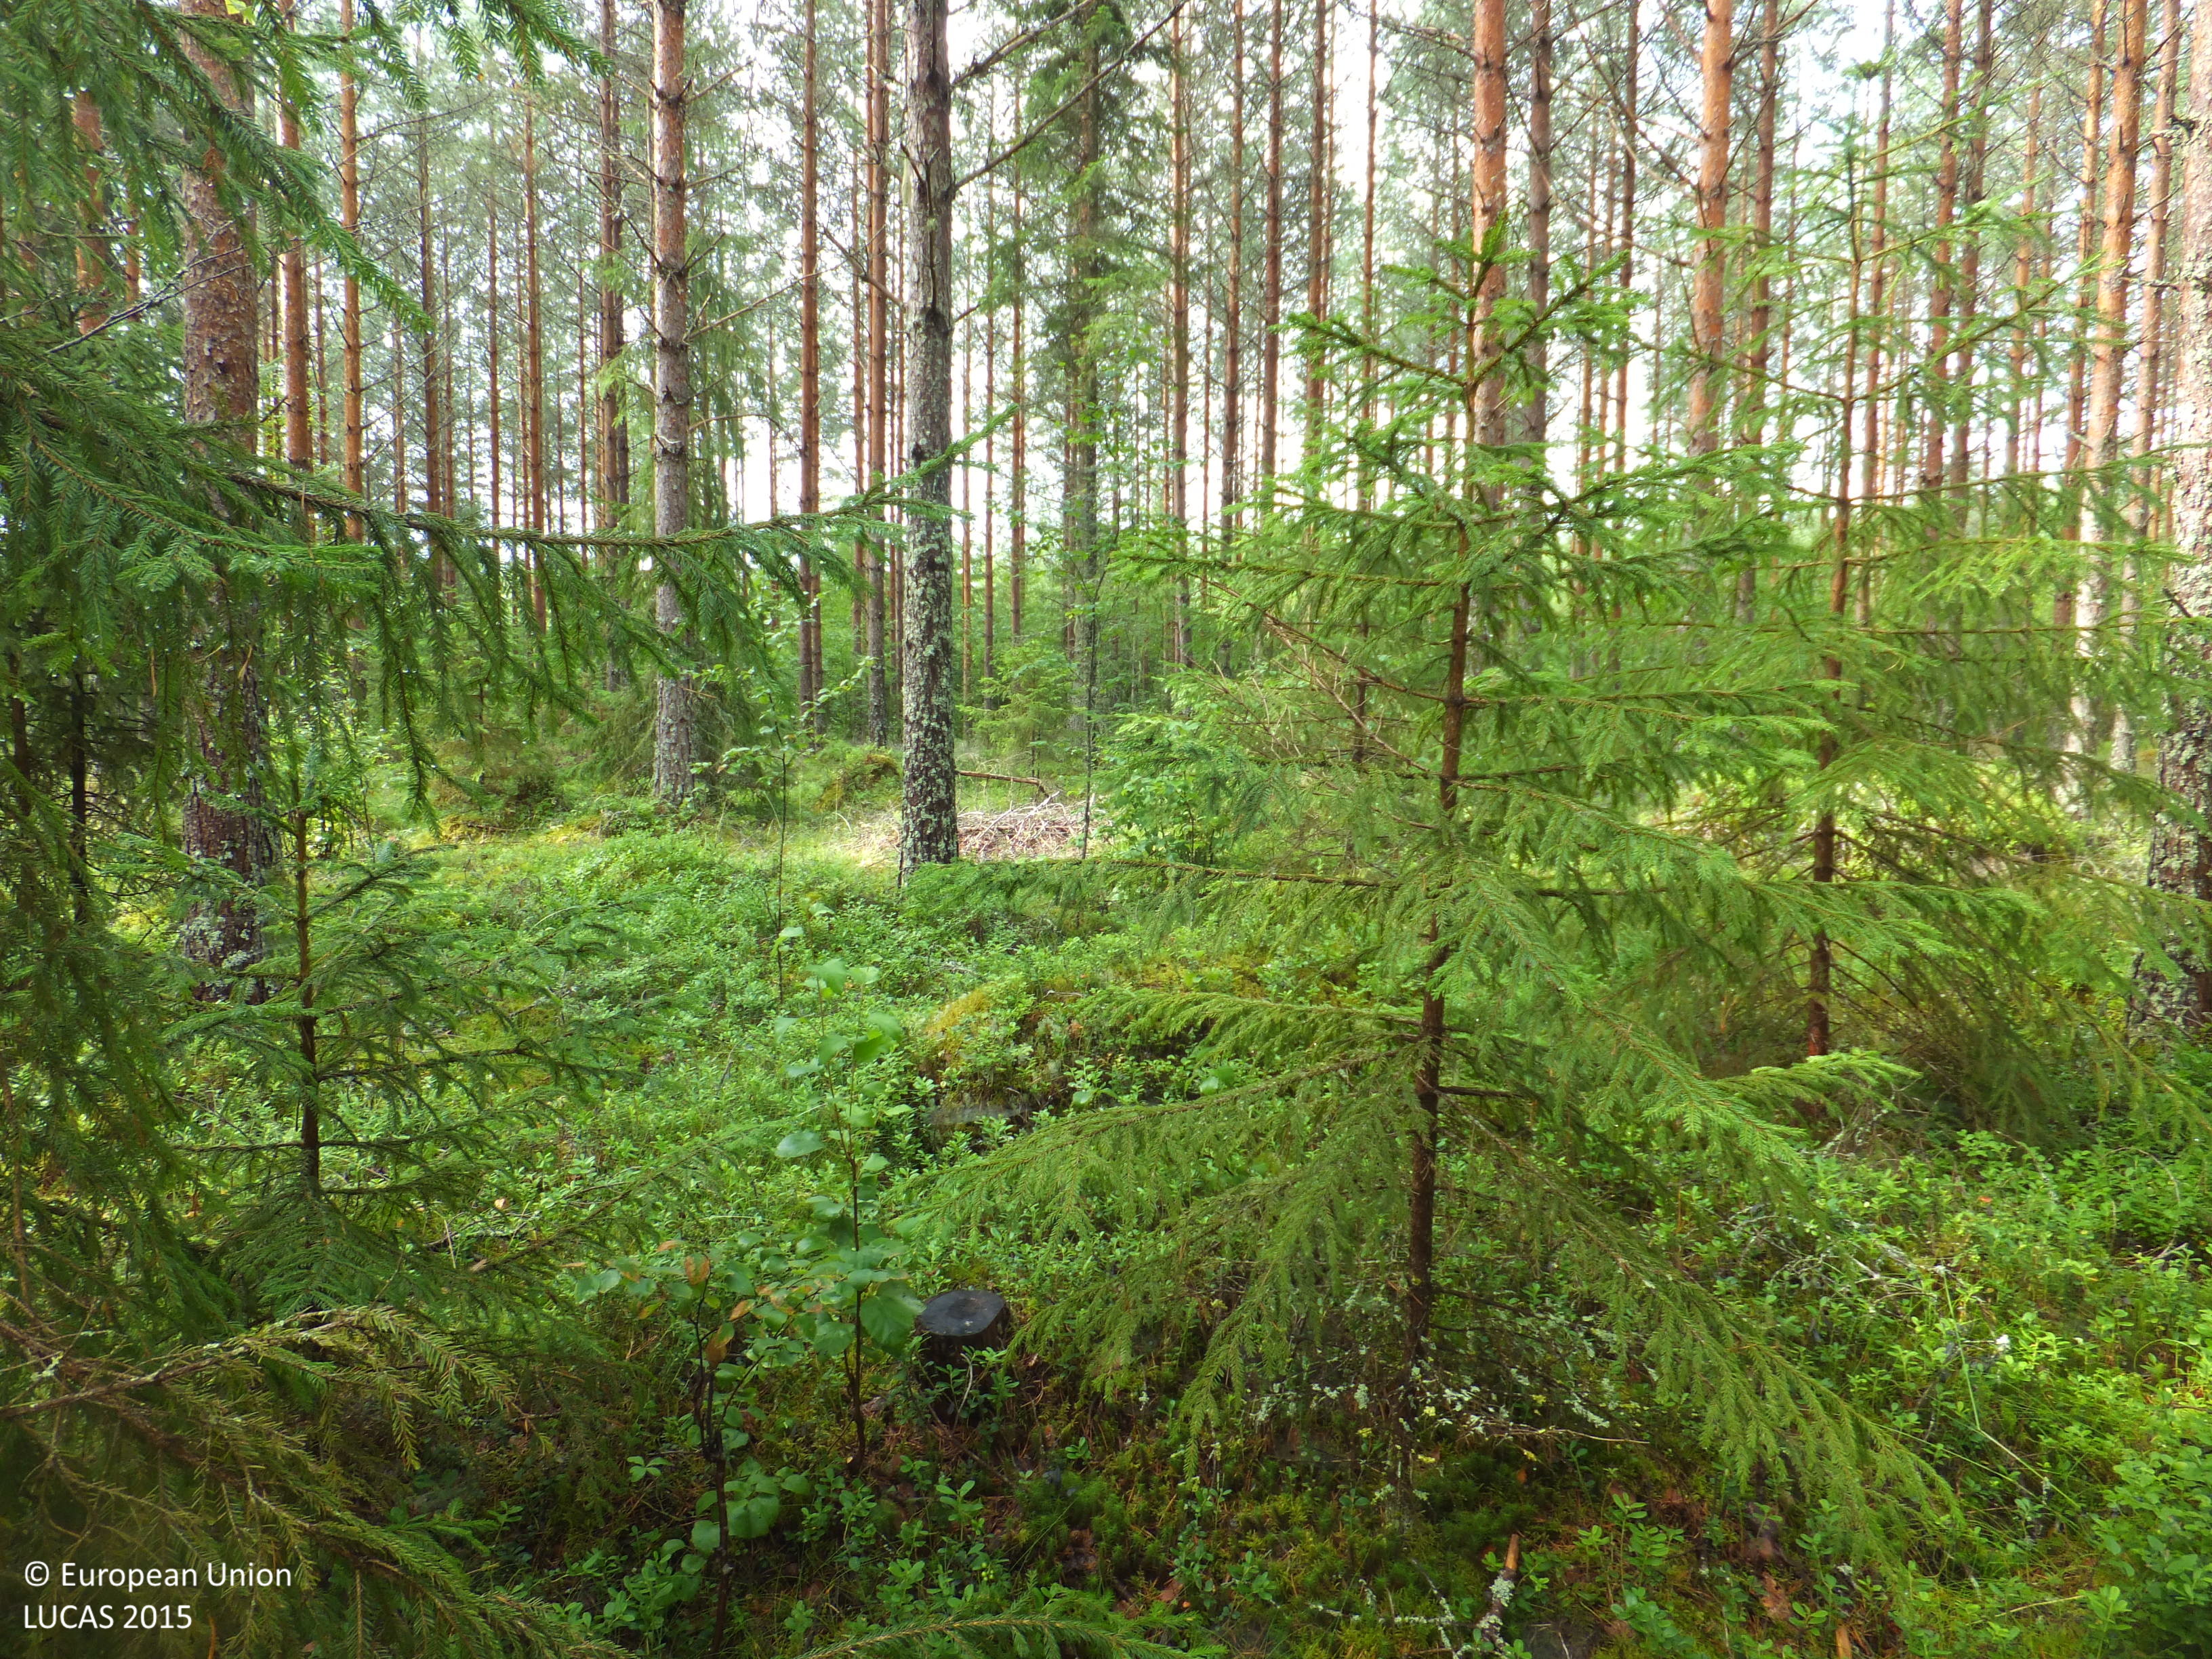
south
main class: Woodland
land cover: Pine dominated coniferous woodland
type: boreal forest
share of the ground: > 75 %
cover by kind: coniferous forest trees 70 %, shrubs 10 %, lichens and mosses 10 %, broadleaved forest trees 5 %, herbaceous plants 5 %
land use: Forestry
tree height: > 5 m
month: July
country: FI
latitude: 63.1711
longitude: 22.0196
